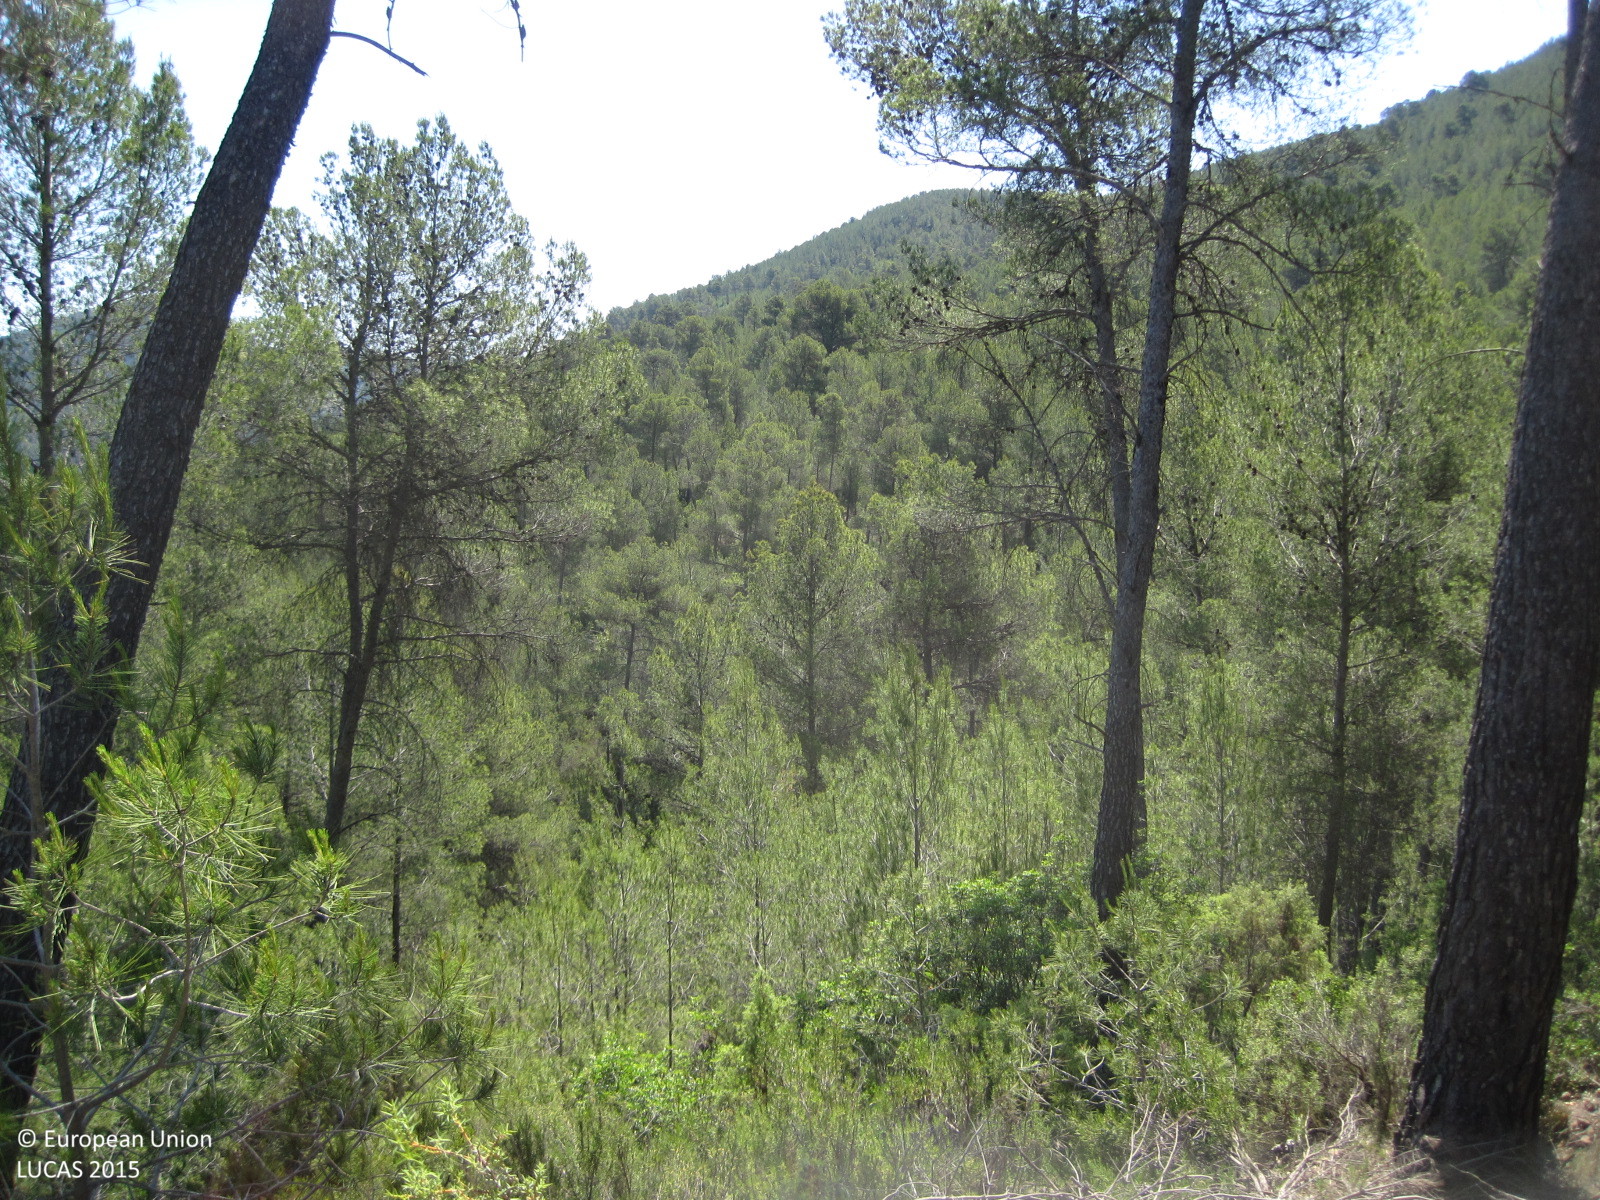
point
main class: Woodland
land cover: Pine dominated coniferous woodland
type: coniferous forest of the mediterranean region
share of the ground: 50 - 75 %
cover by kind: coniferous forest trees 70 %, shrubs 30 %
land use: Forestry
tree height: > 5 m
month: June
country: ES
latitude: 39.7599
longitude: -1.1284
